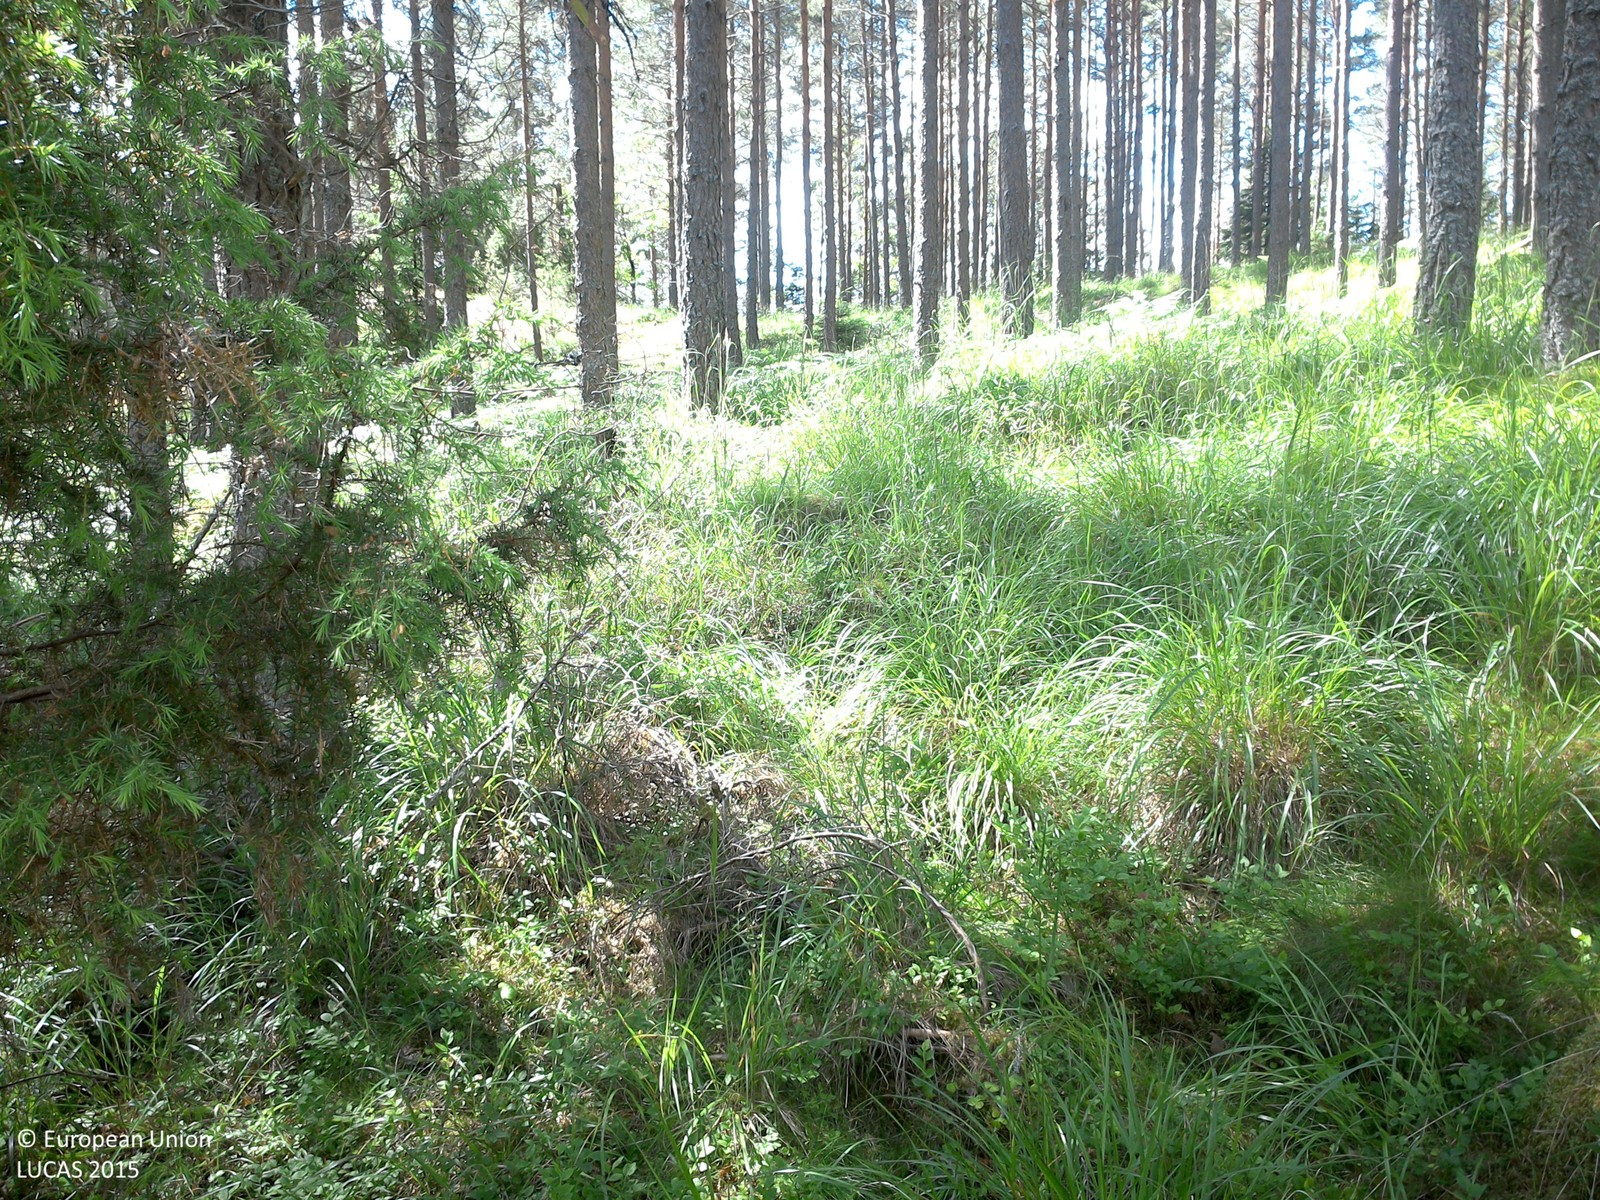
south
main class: Woodland
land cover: Pine dominated coniferous woodland
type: boreal forest
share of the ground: 50 - 75 %
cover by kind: coniferous forest trees 70 %, herbaceous plants 30 %
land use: Forestry
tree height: > 5 m
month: June
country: SE
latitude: 57.9804
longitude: 15.9318
